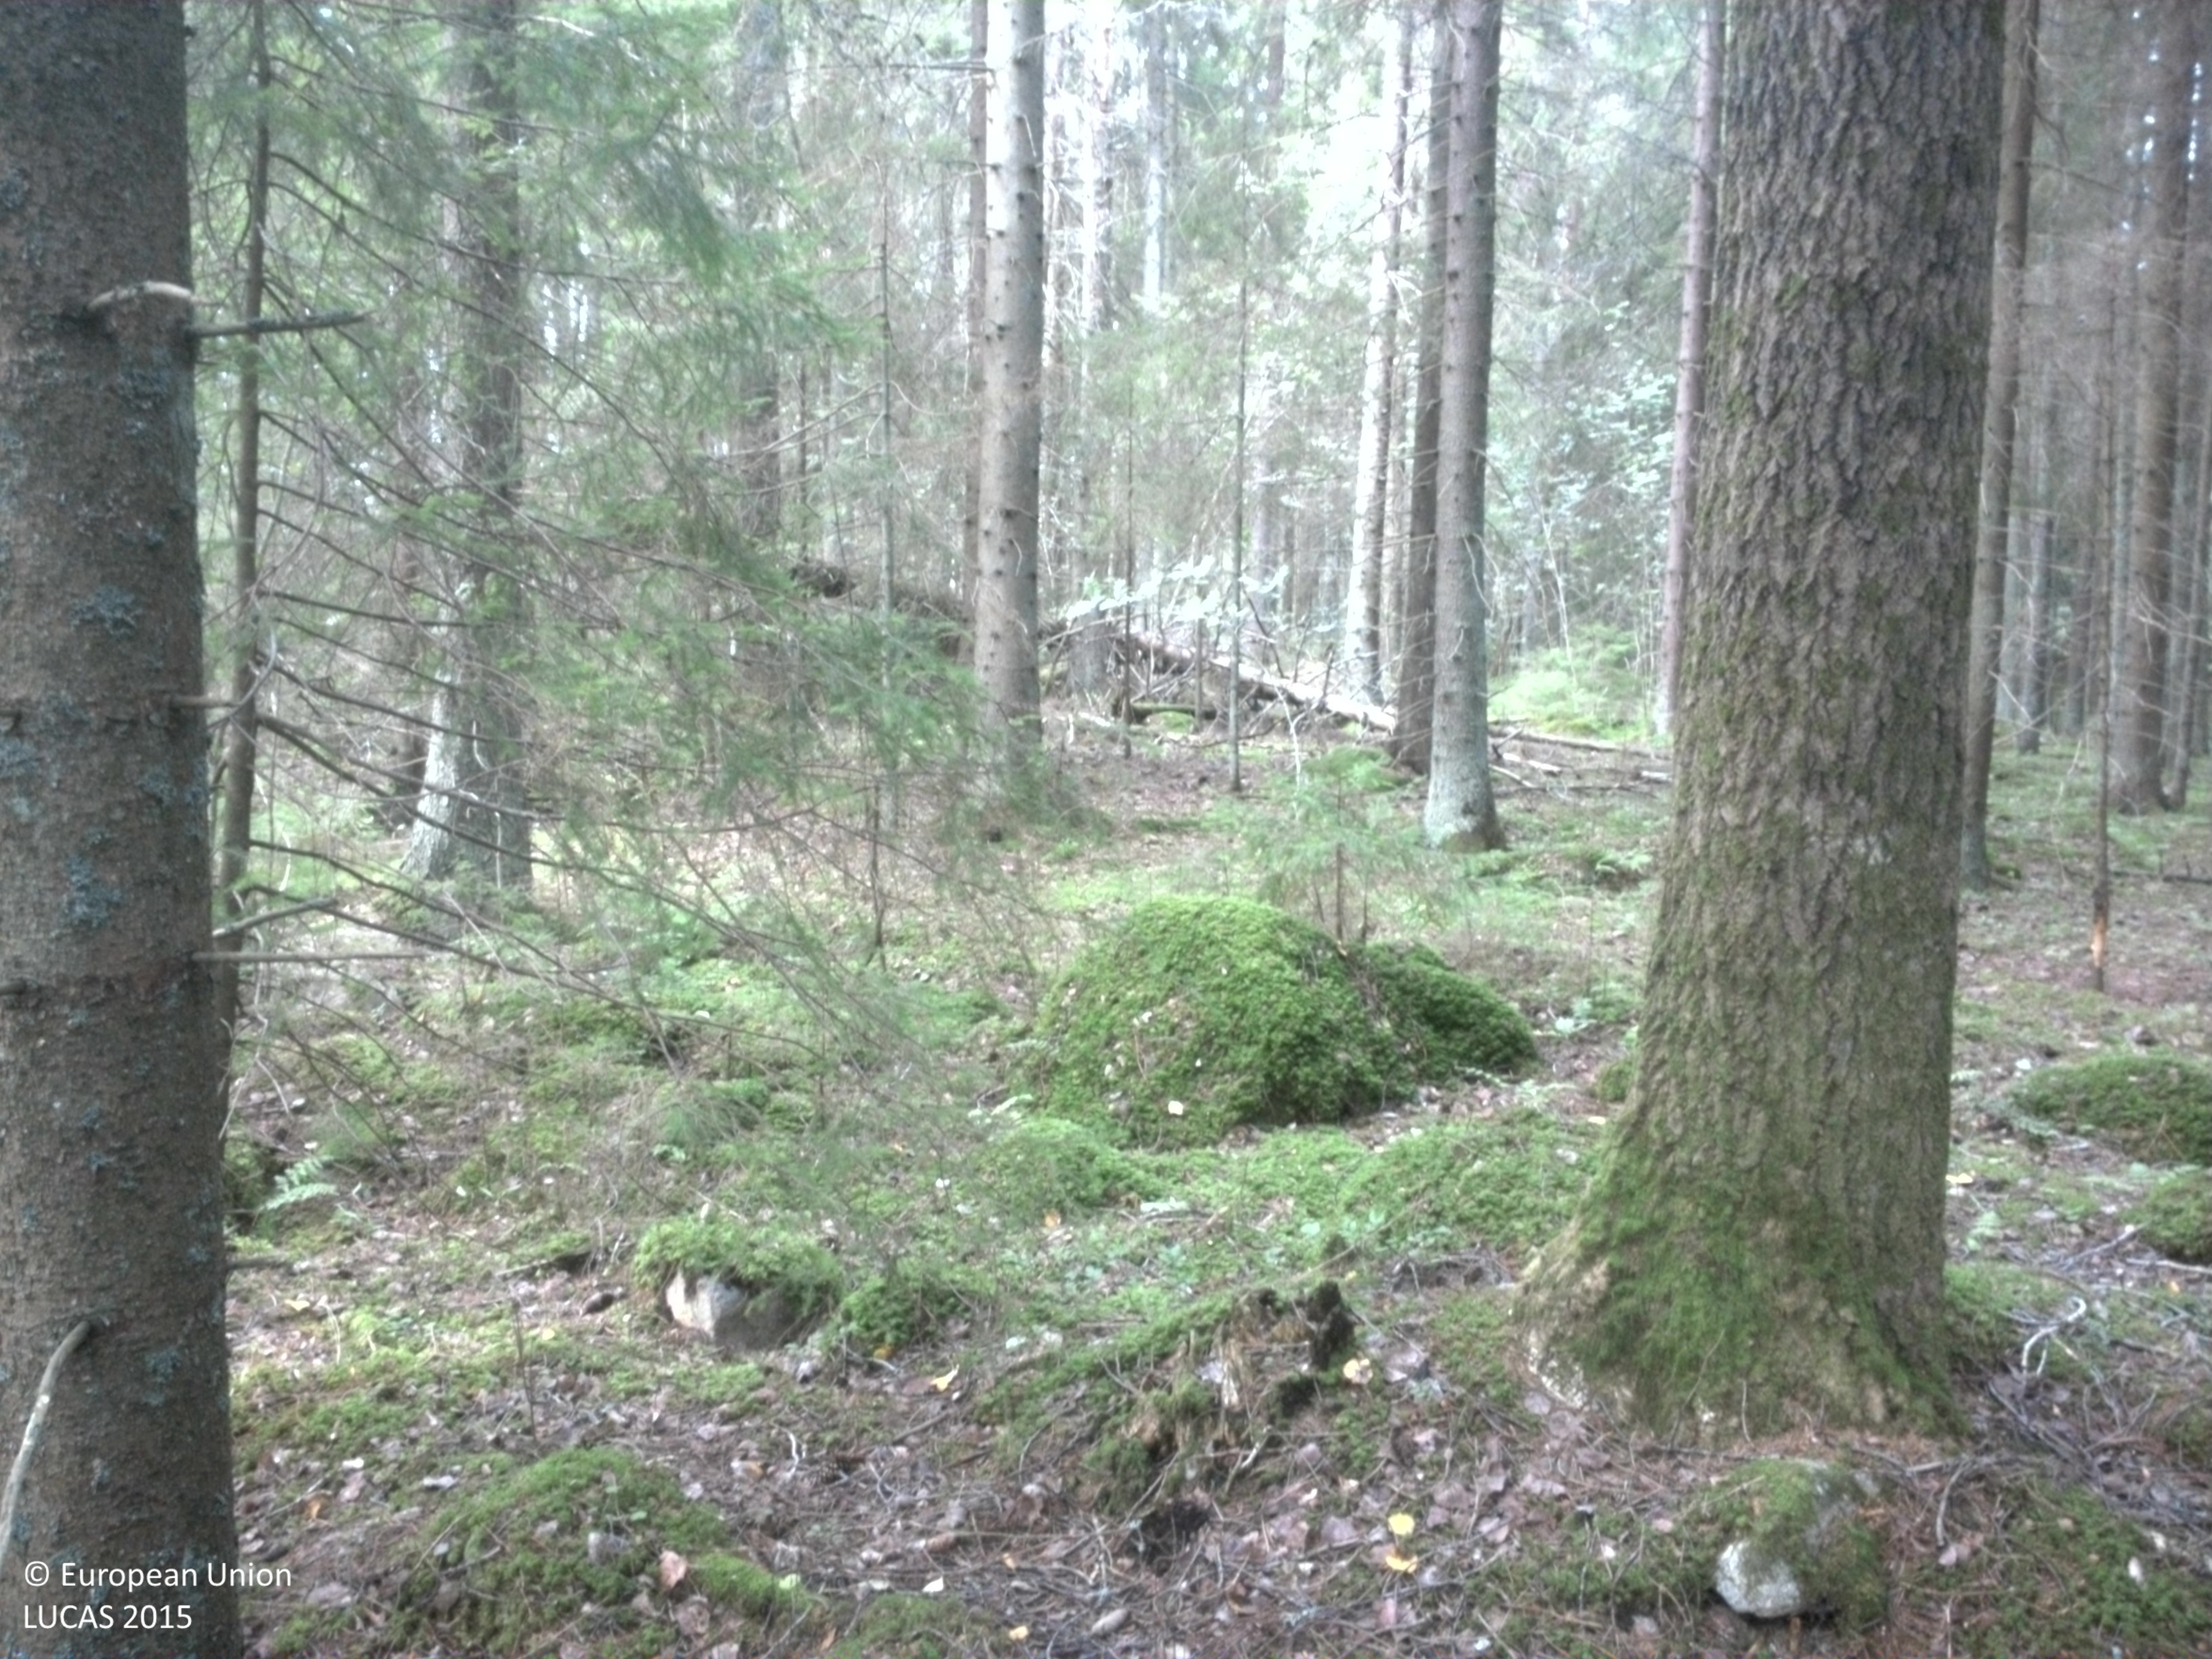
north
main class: Woodland
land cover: Spruce dominated coniferous woodland
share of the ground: > 75 %
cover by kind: coniferous forest trees 70 %, lichens and mosses 15 %, broadleaved forest trees 10 %, shrubs 5 %
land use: Forestry
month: September
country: SE
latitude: 59.4910
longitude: 15.6246
